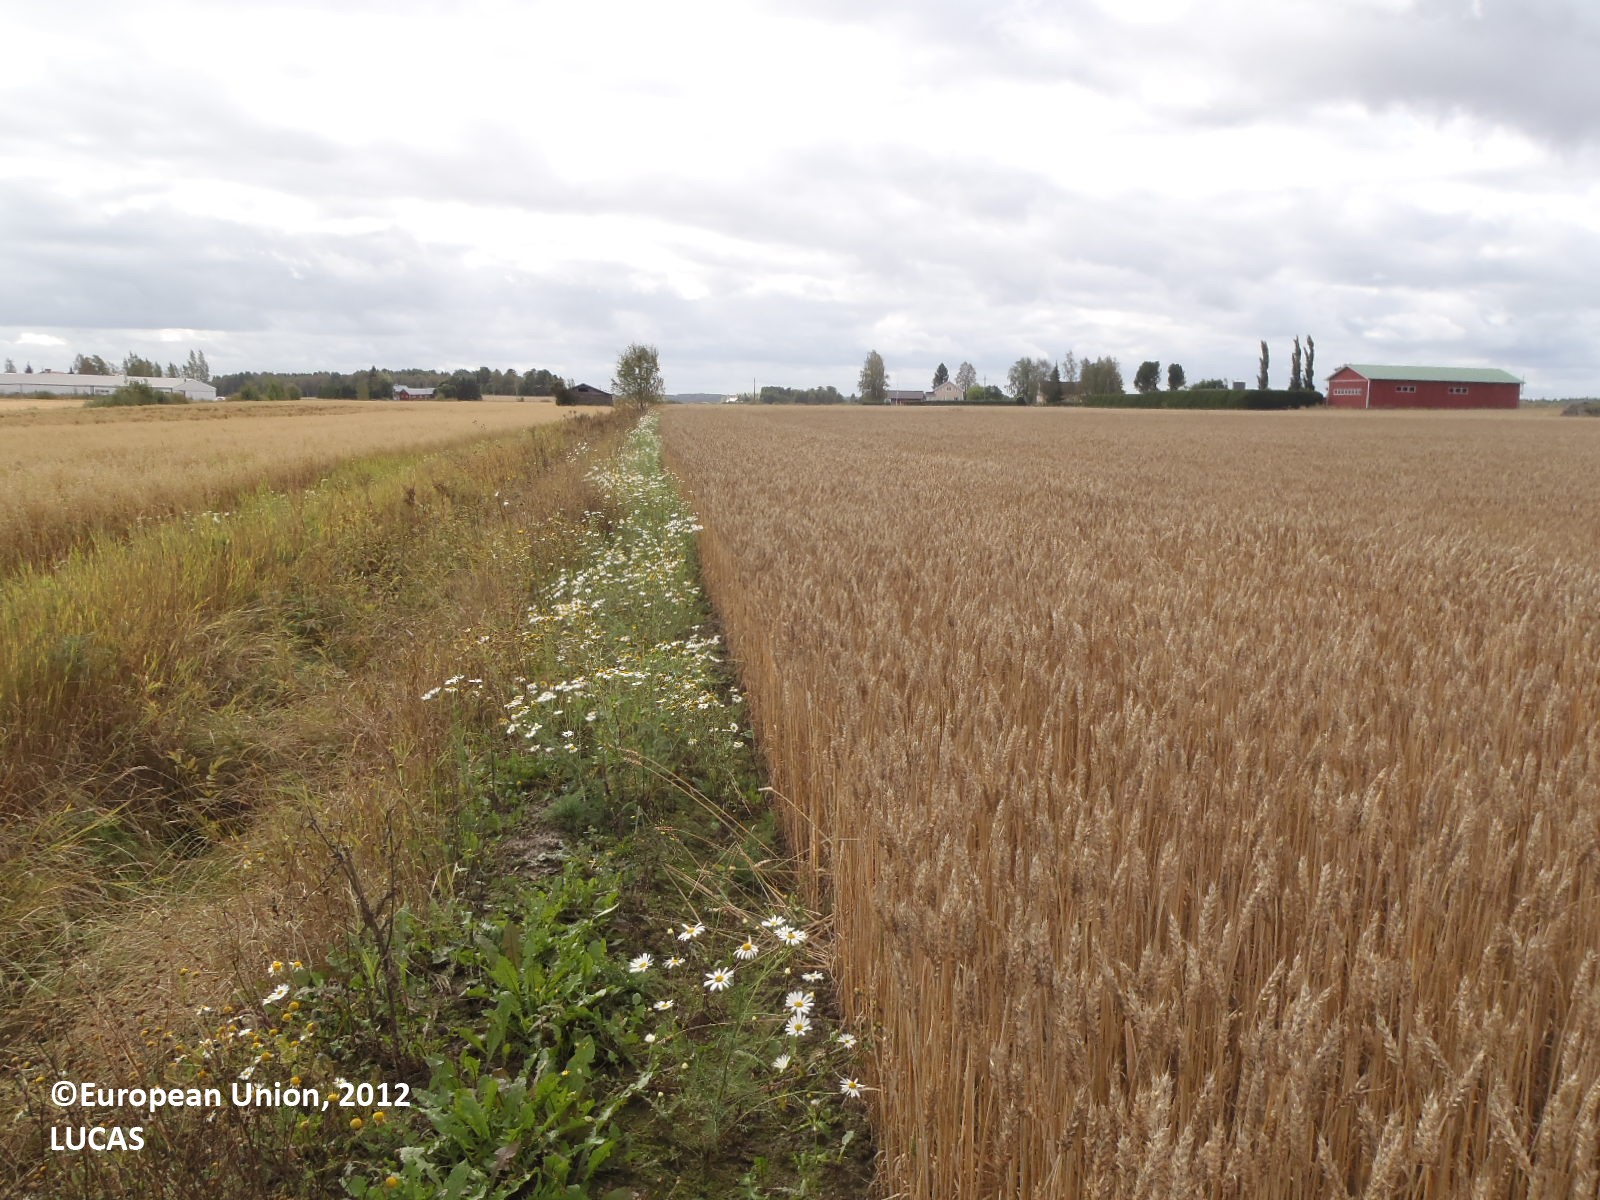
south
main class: Cropland
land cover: Common wheat
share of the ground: > 75 %
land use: Agriculture (excluding fallow land and kitchen gardens)
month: September
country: FI
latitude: 61.2708
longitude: 22.6560
